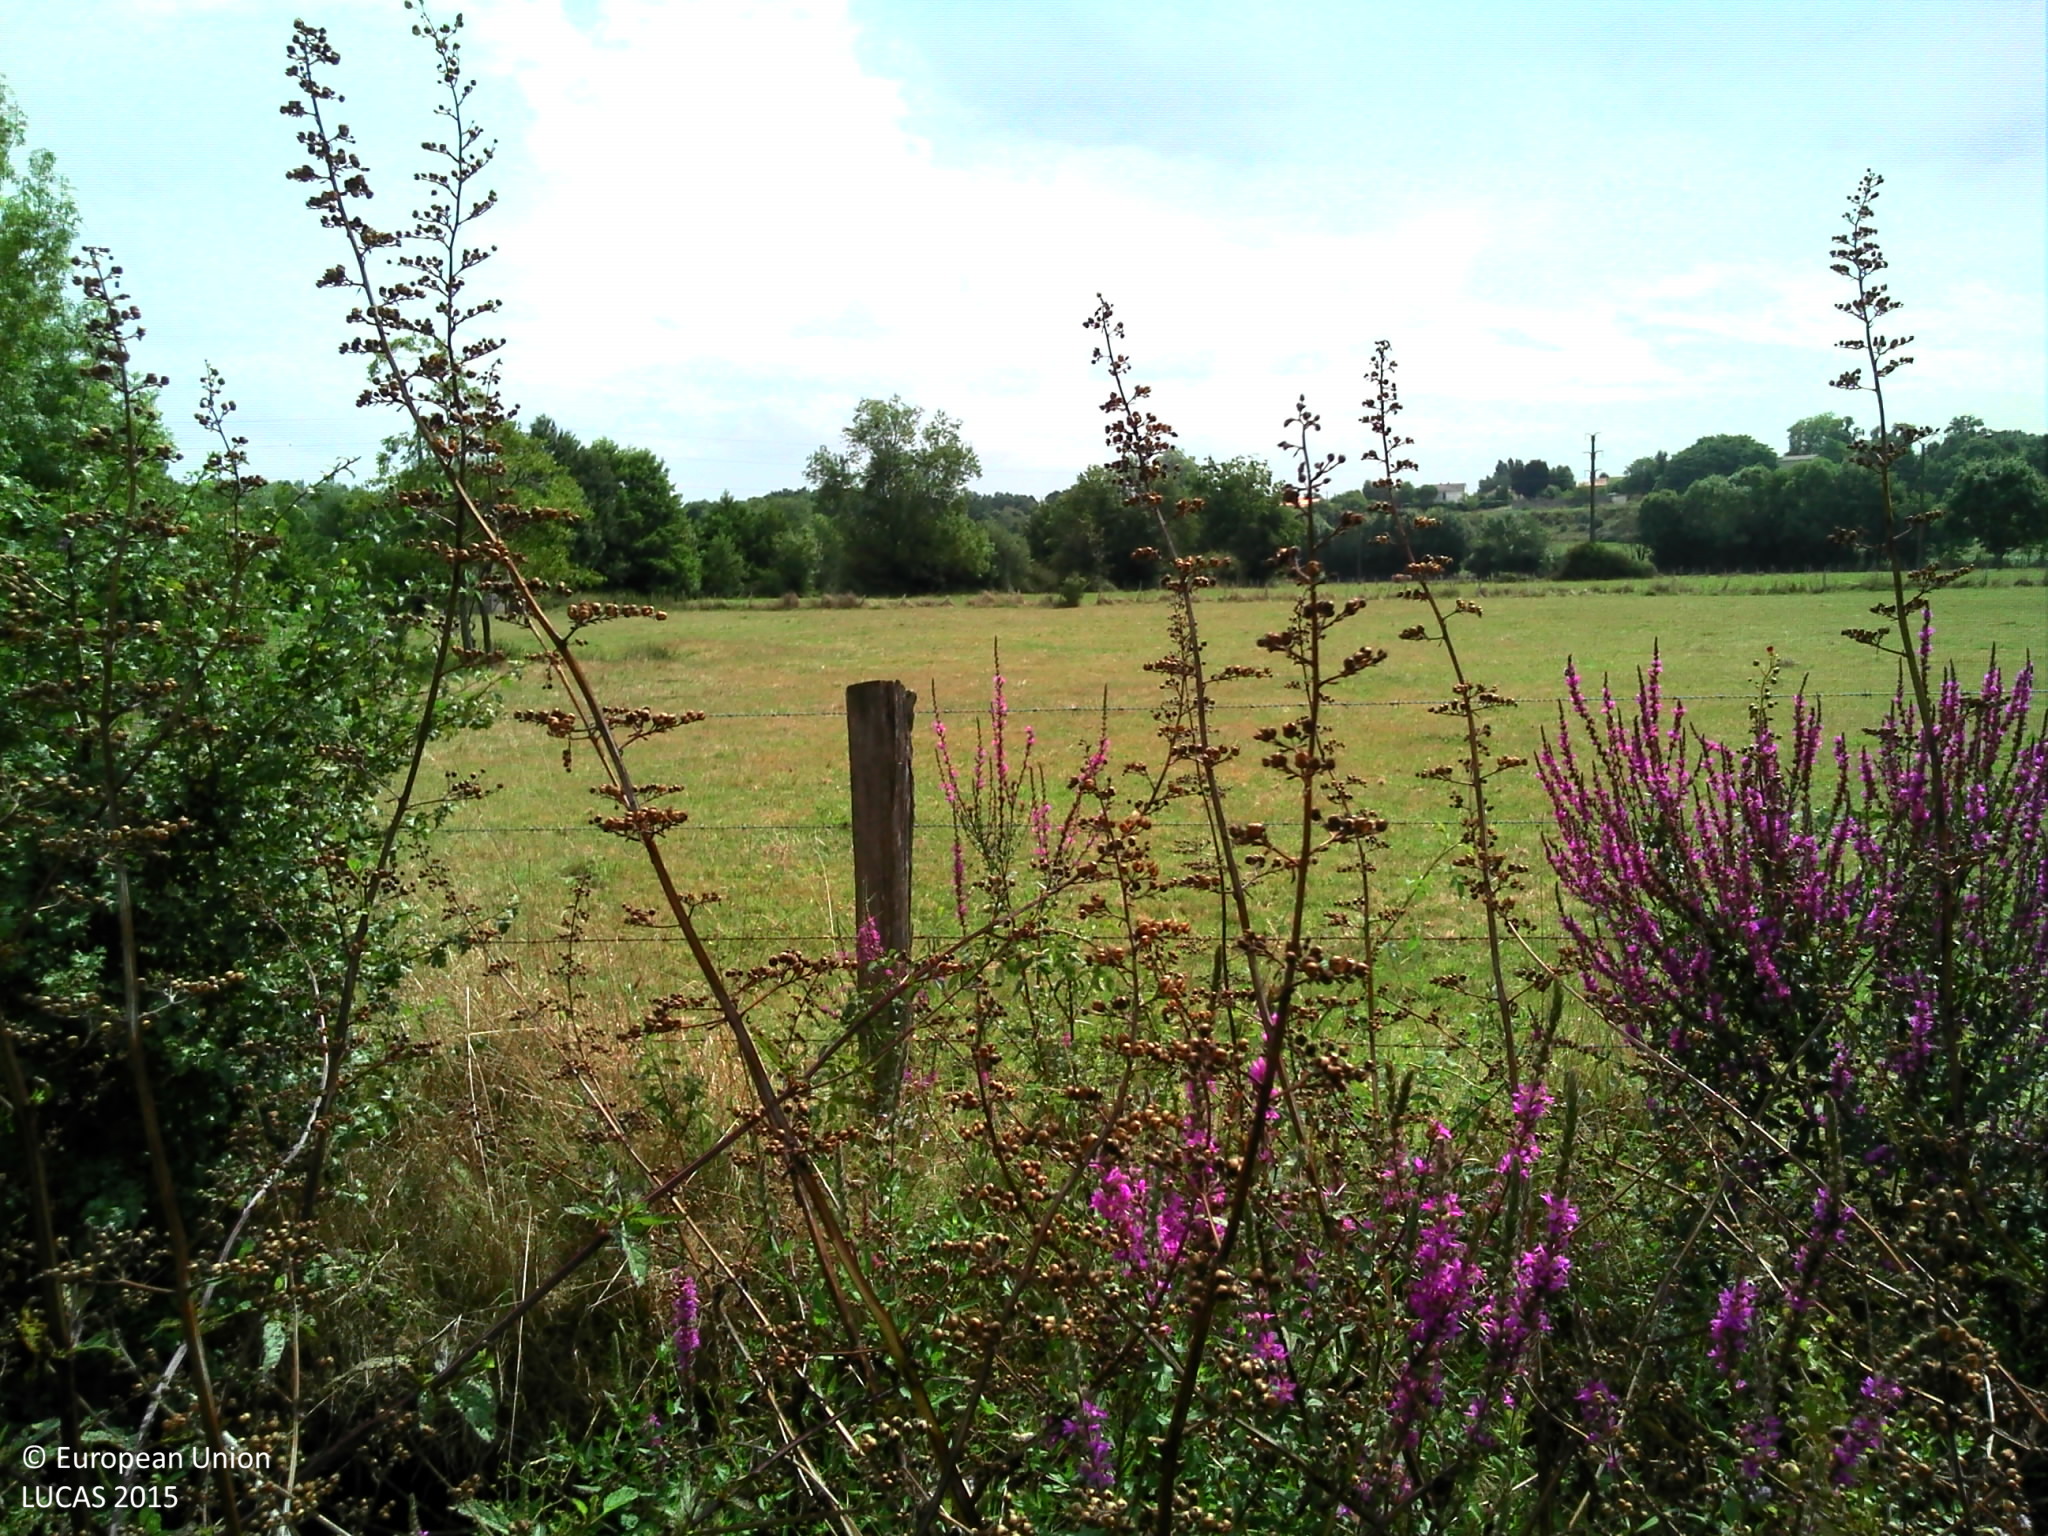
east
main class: Grassland
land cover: Grassland without tree/shrub cover
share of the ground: > 75 %
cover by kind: herbaceous plants 100 %
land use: Agriculture (excluding fallow land and kitchen gardens)
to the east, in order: Ditches and canals; Grass margins; Tracks; Abandoned hedges; Fences; Grassland without tree/shrub cover; Electric lines; Grassland without tree/shrub cover; Fences; Abandoned hedges; Grass margins; Inland fresh running water; Grassland without tree/shrub cover
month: August
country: FR
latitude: 46.1415
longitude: 0.2601
